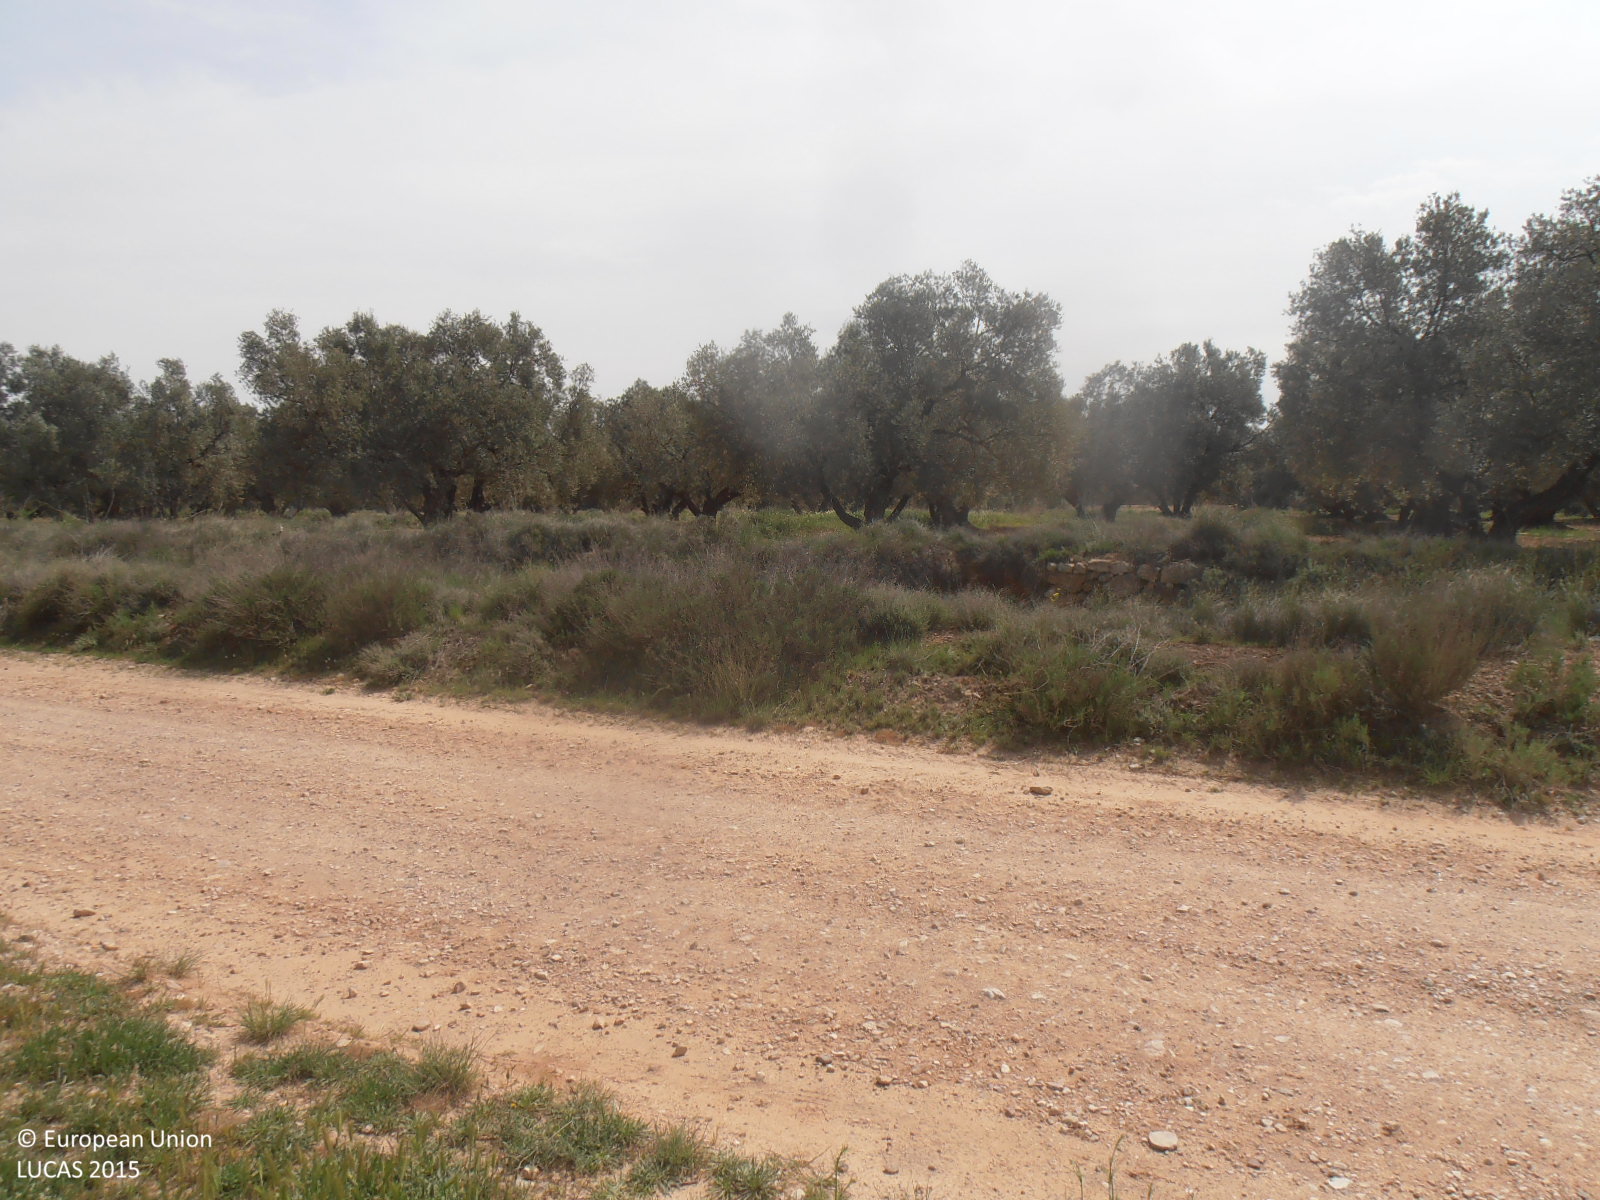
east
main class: Grassland
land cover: Grassland with sparse tree/shrub cover
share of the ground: > 75 %
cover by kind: herbaceous plants 90 %, broadleaved forest trees 5 %, shrubs 5 %
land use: Abandoned areas
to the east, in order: Grassland with sparse tree/shrub cover; Tracks; Shruby margins; Ditches and canals; Shruby margins; Olive groves; Grass margins; Olive groves; Grass margins; Olive groves; Grass margins; Ditches and canals; Grass margins; Olive groves; Grass margins; Olive groves; Grass margins; Other bare soil; Grass margins; Ditches and canals; Grass margins; Olive groves
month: April
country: ES
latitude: 41.3172
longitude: -0.7331
